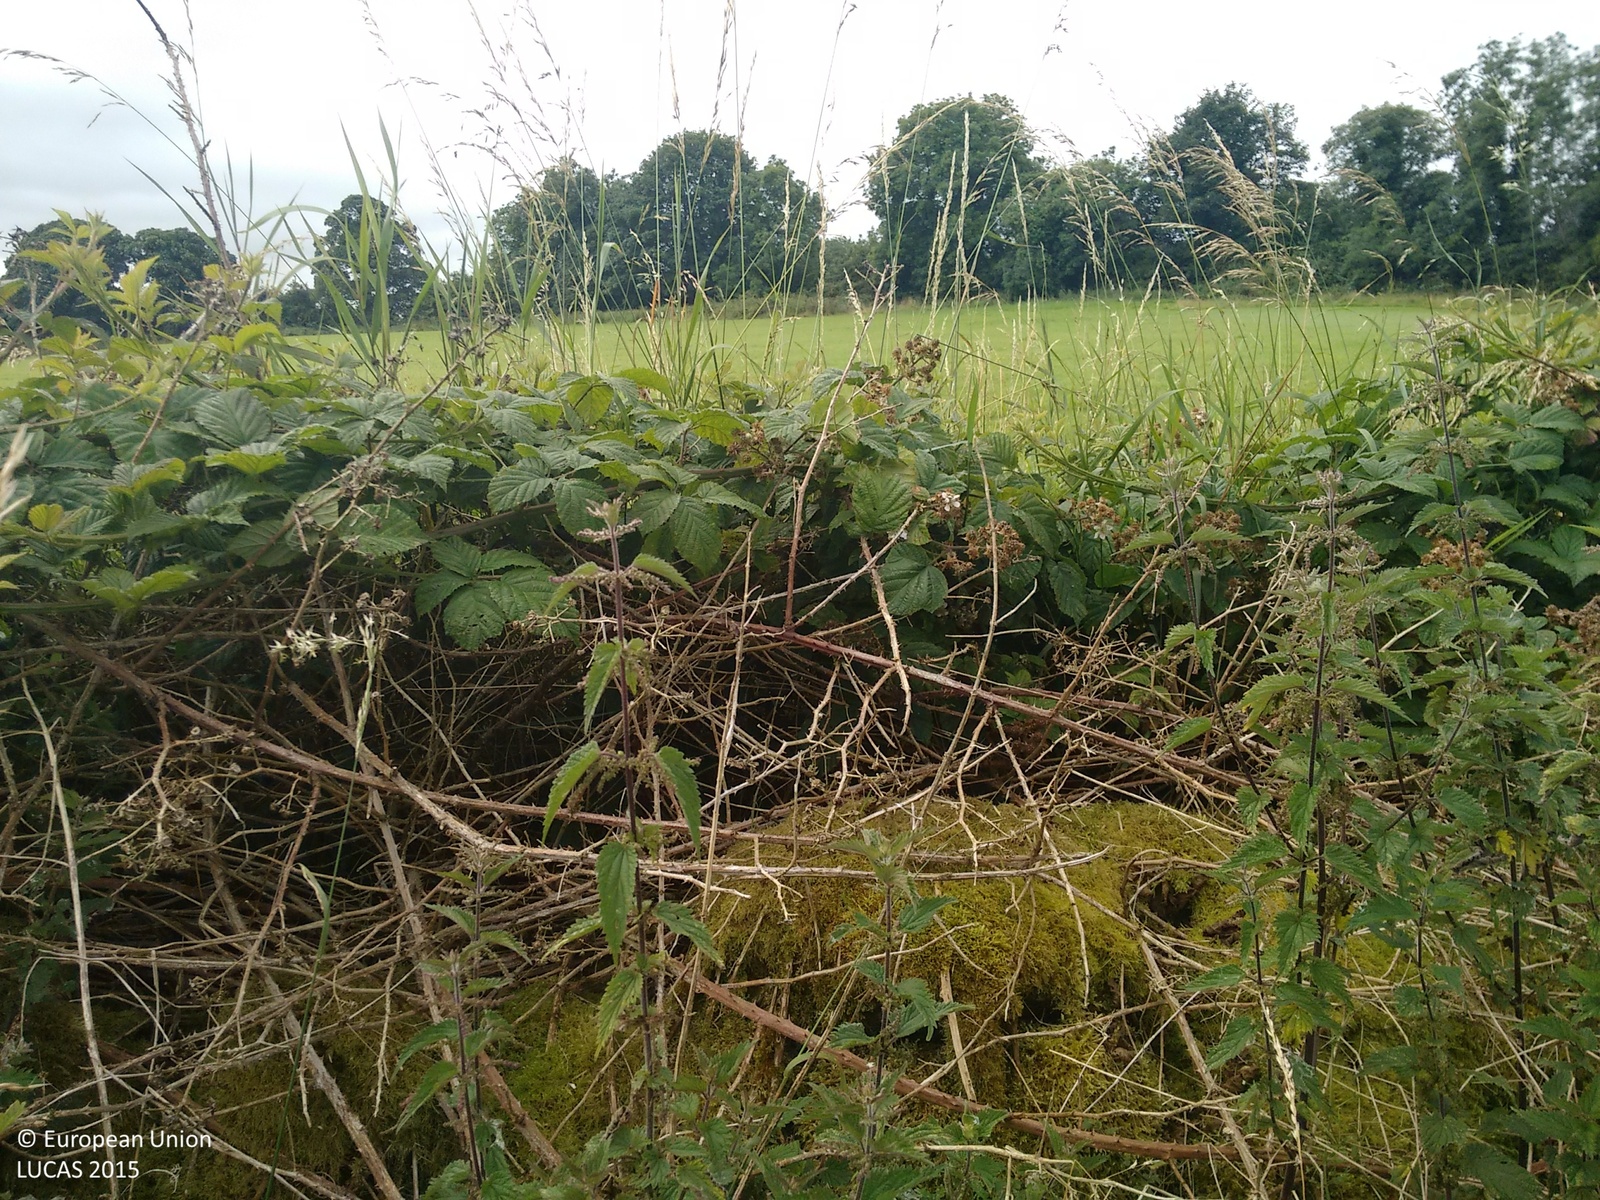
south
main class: Woodland
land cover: Pine dominated mixed woodland
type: exotic forest
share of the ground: > 75 %
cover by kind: coniferous forest trees 75 %, broadleaved forest trees 25 %
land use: Residential
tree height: > 5 m
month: August
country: GB
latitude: 54.1944
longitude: -6.3208
